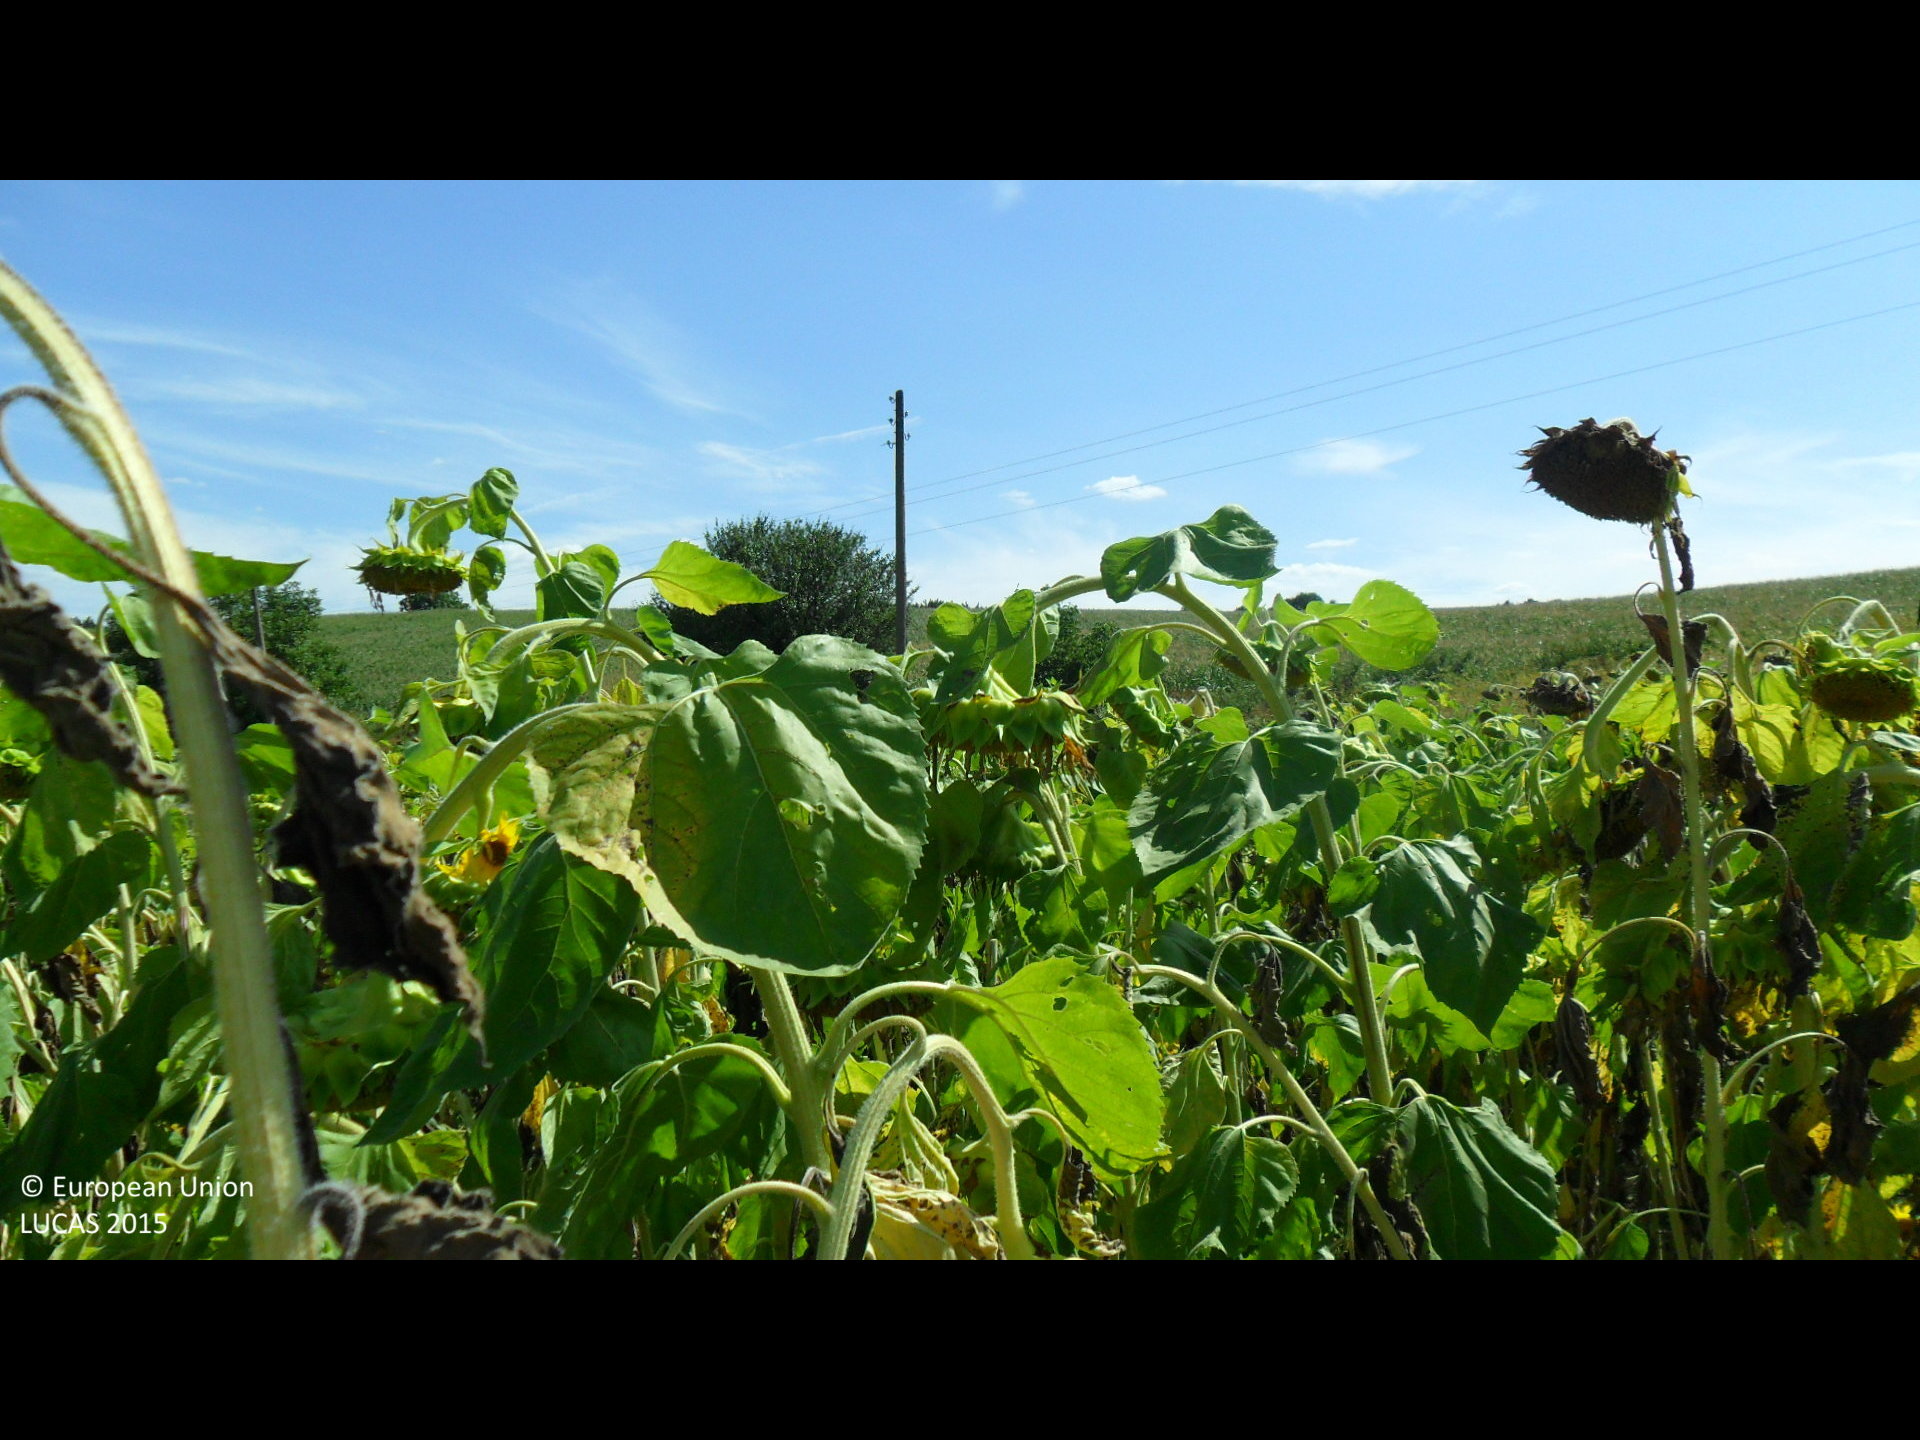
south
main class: Cropland
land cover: Sunflower
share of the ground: > 75 %
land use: Agriculture (excluding fallow land and kitchen gardens)
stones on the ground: < 10 %
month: August
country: BG
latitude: 43.3206
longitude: 26.3386
